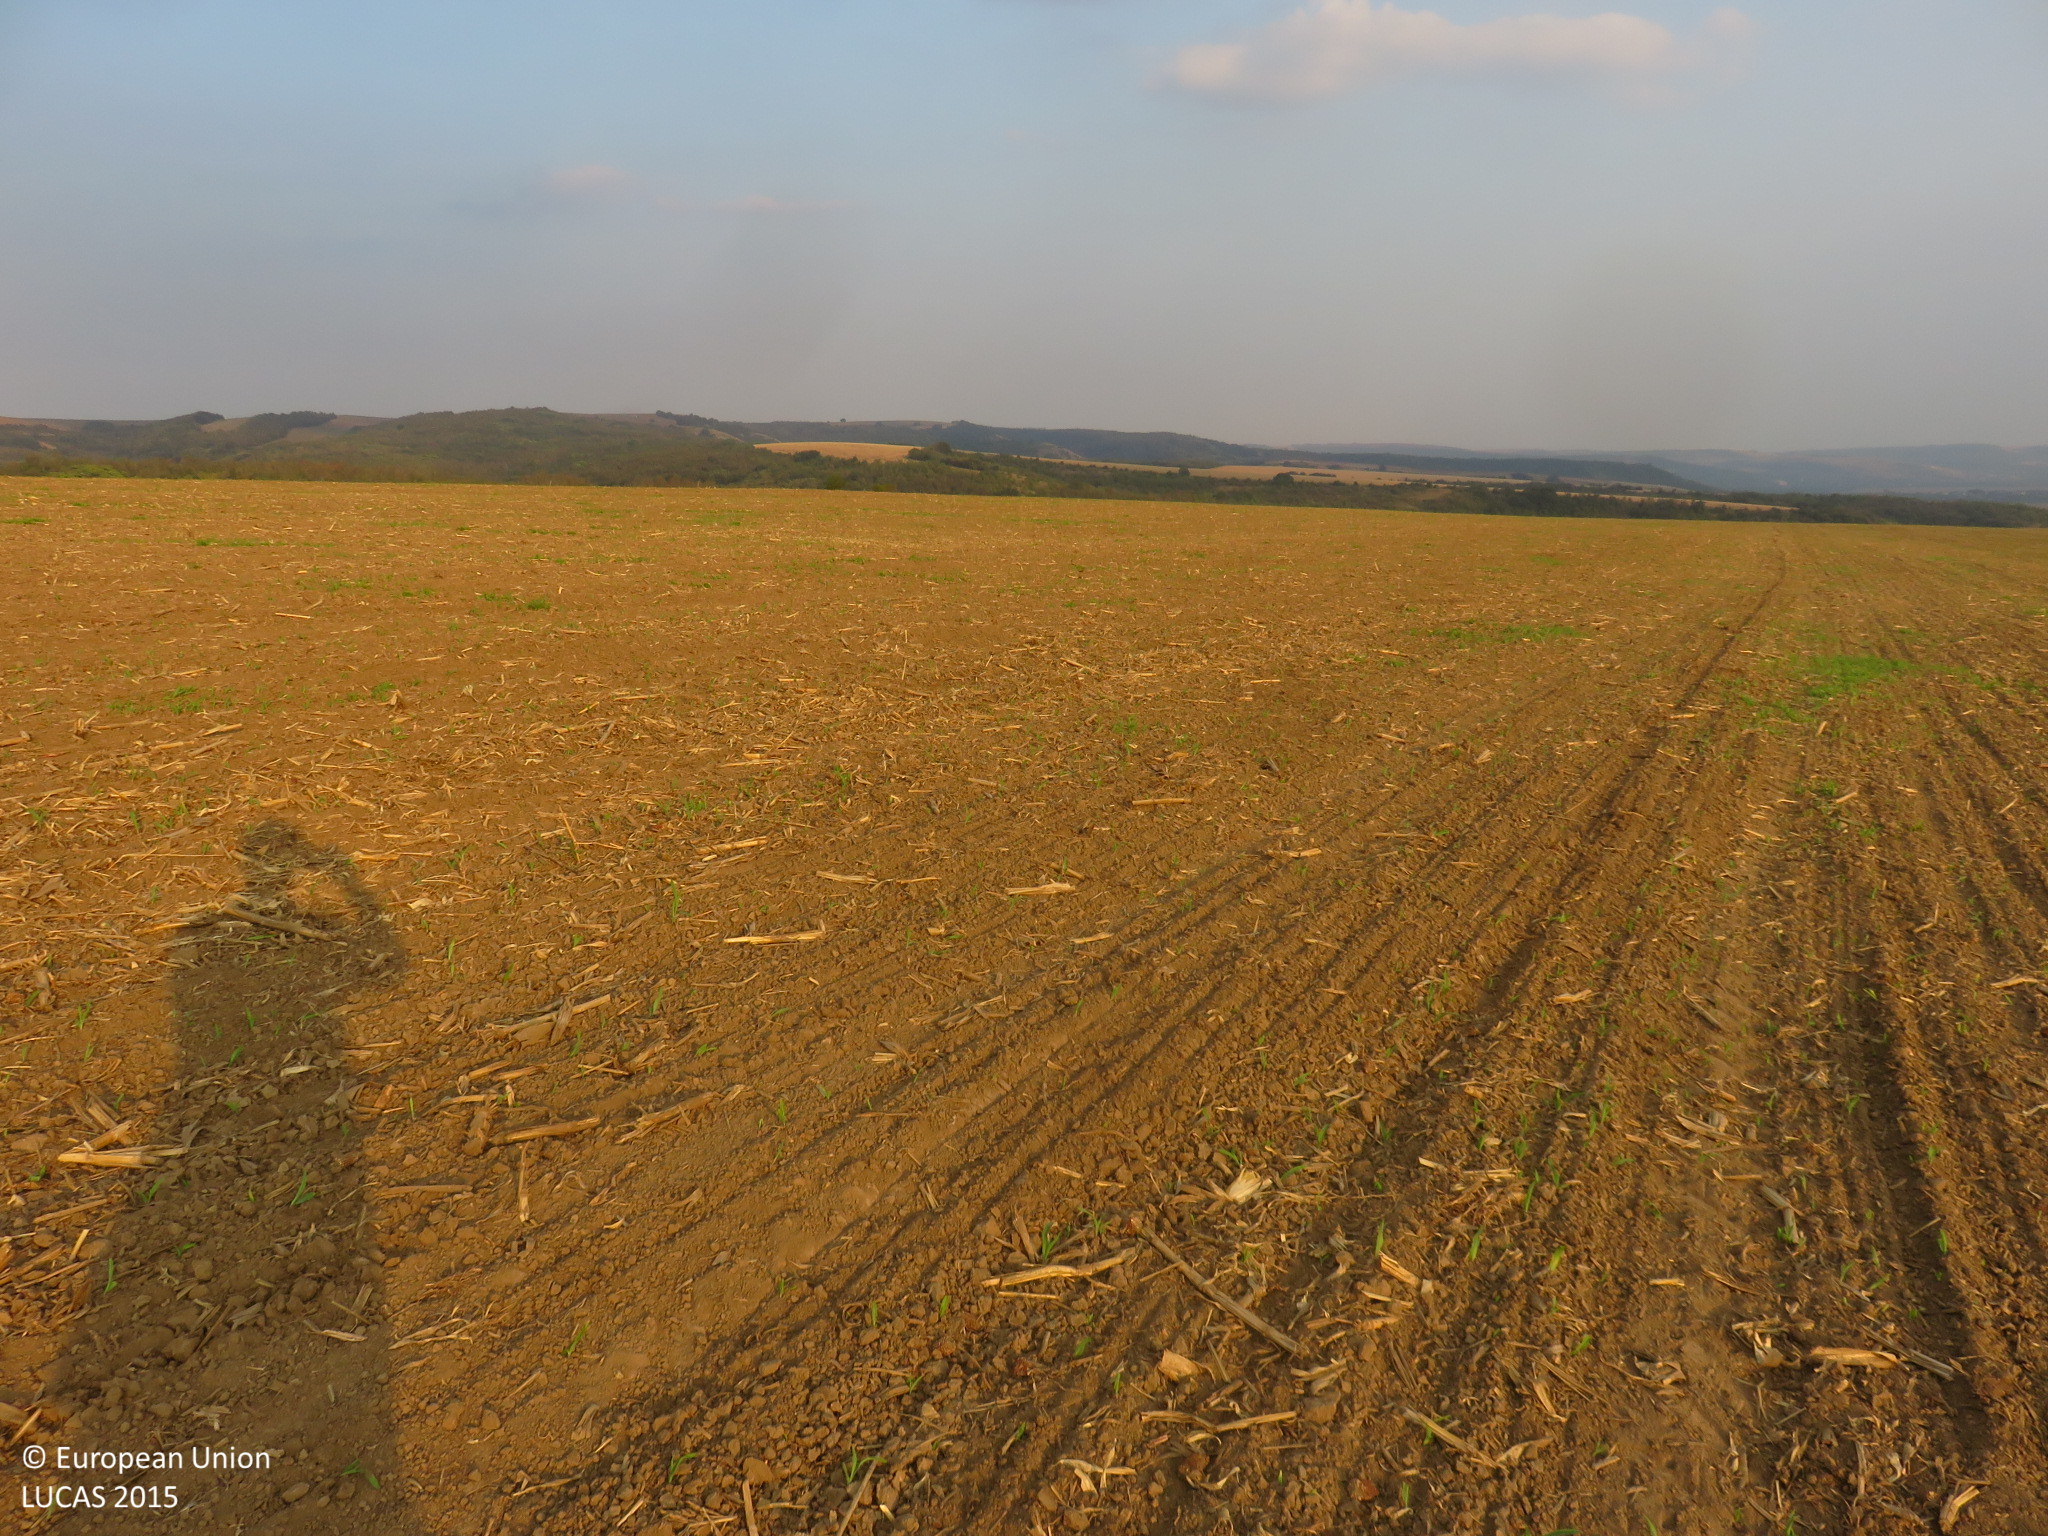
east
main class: Cropland
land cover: Maize
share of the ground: < 10 %
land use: Agriculture (excluding fallow land and kitchen gardens)
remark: Harvested field
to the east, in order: Maize
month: September
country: BG
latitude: 43.5693
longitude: 24.9664
